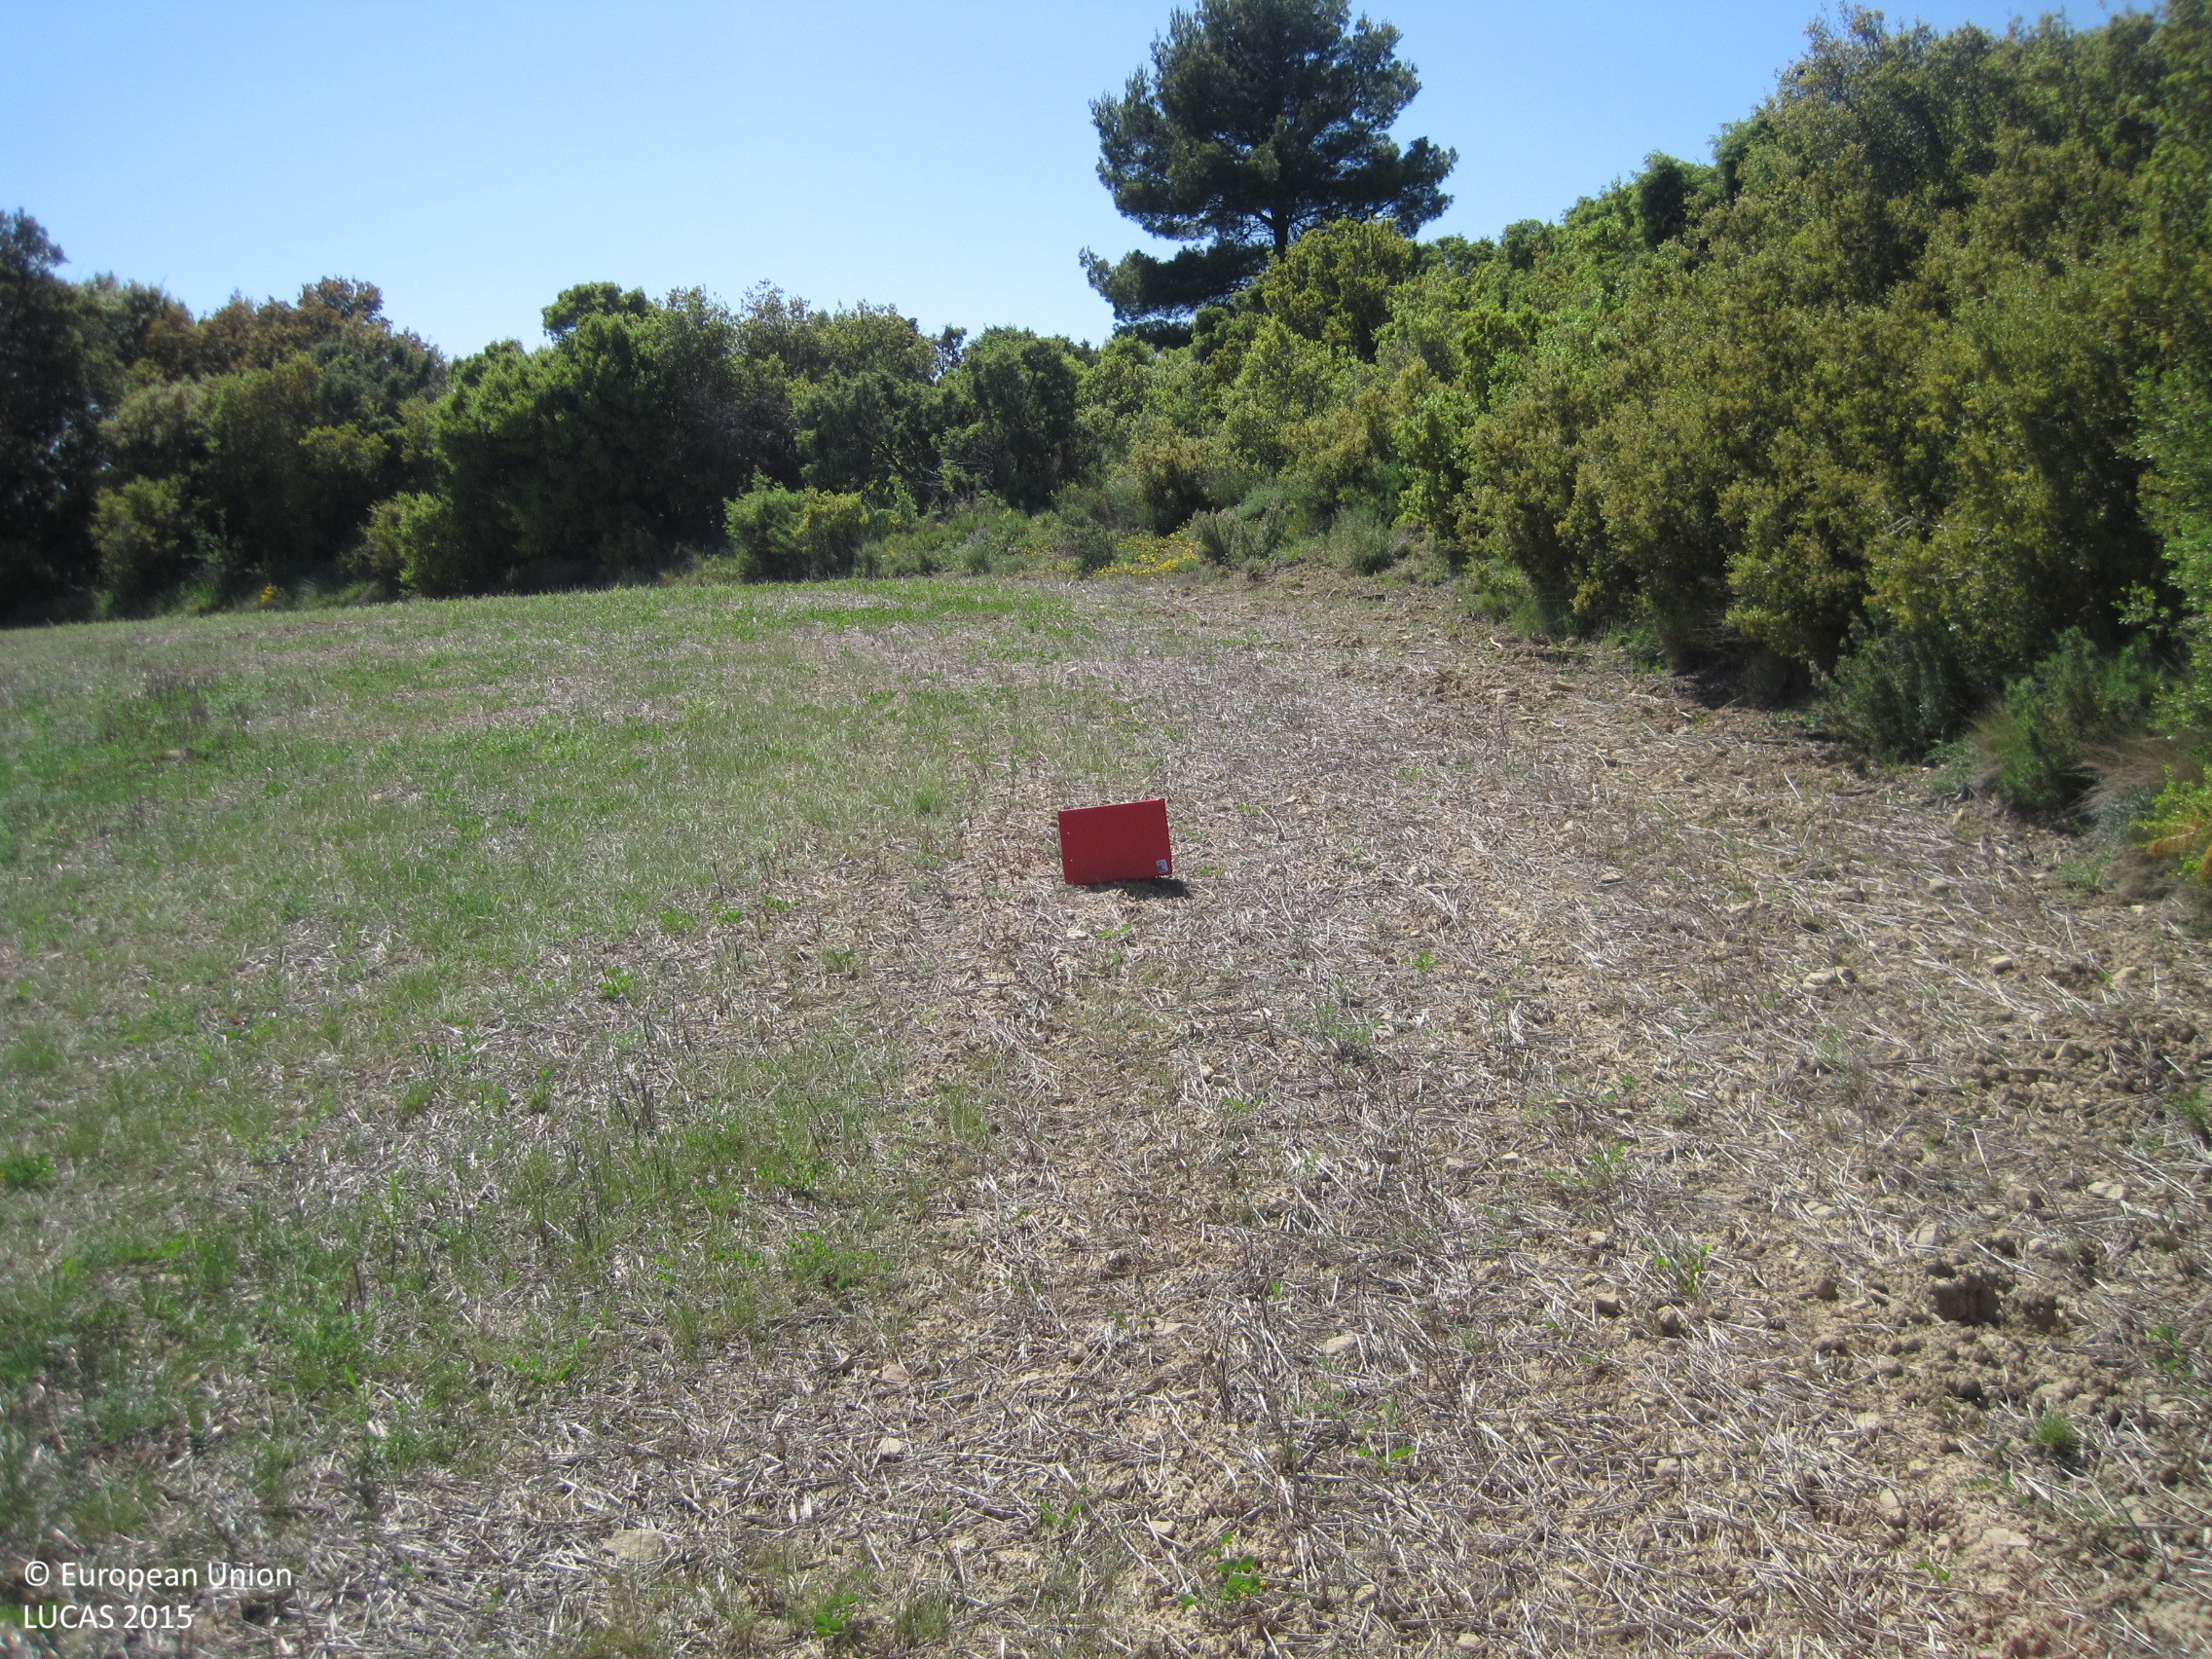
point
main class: Grassland
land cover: Spontaneously vegetated surfaces
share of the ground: > 75 %
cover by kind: herbaceous plants 60 %, unconsolidated bare surface 40 %
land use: Fallow land
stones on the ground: < 10 %
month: May
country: ES
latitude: 42.5303
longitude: -1.6141
